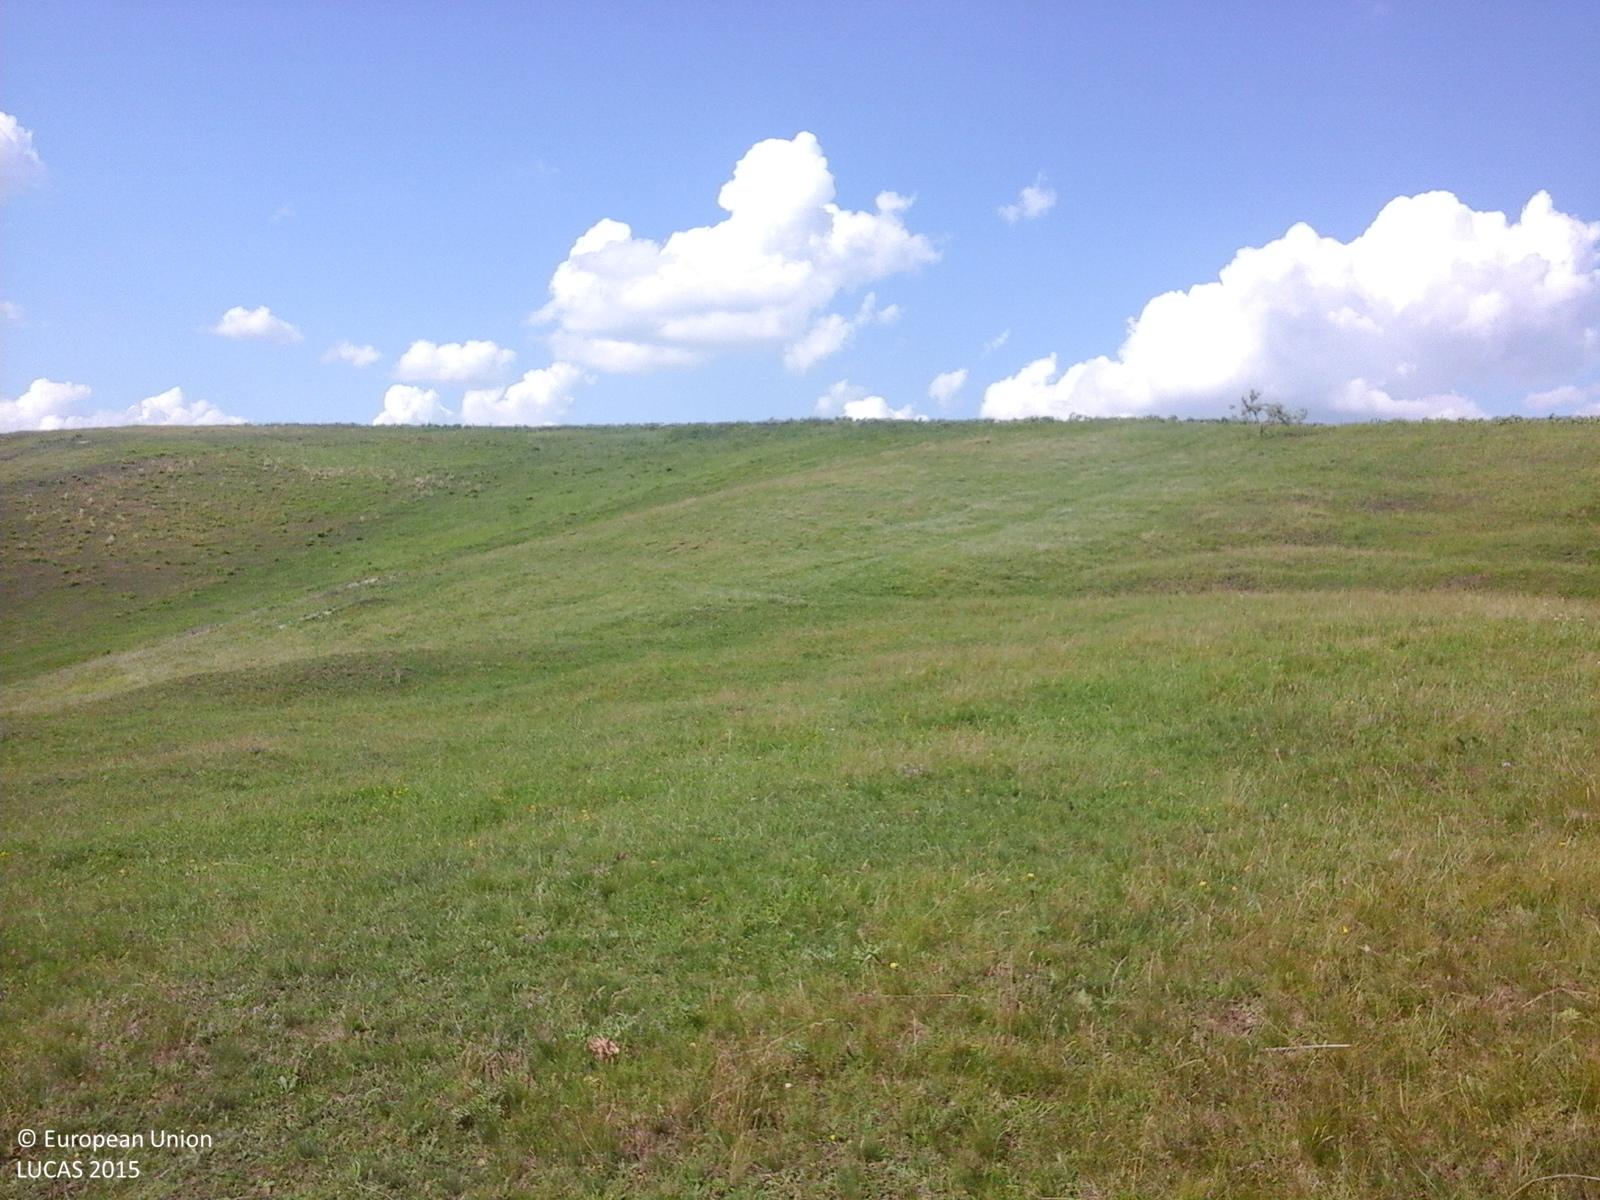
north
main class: Grassland
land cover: Grassland without tree/shrub cover
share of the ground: > 75 %
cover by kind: herbaceous plants 100 %
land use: Agriculture (excluding fallow land and kitchen gardens)
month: June
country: RO
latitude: 48.1934
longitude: 26.6581
